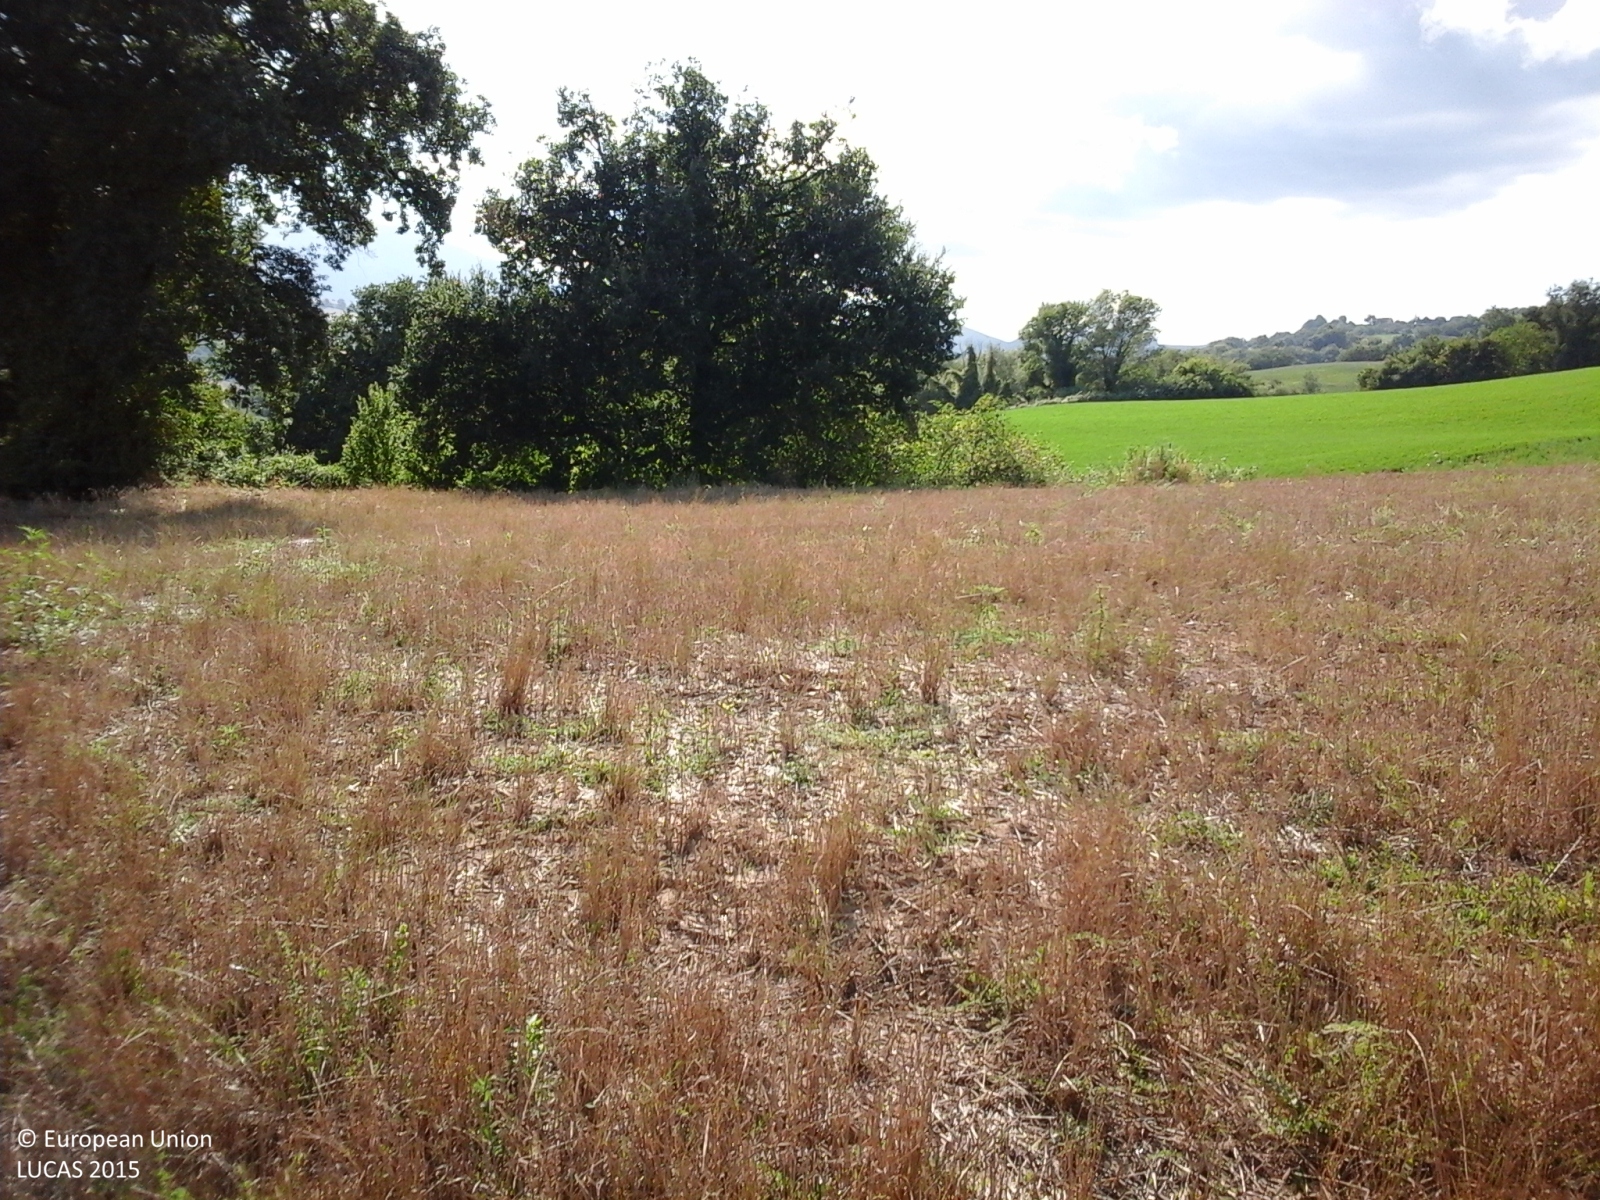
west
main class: Cropland
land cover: Common wheat
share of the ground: > 75 %
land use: Agriculture (excluding fallow land and kitchen gardens)
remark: Harvested field
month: August
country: IT
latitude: 43.0130
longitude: 13.3892
